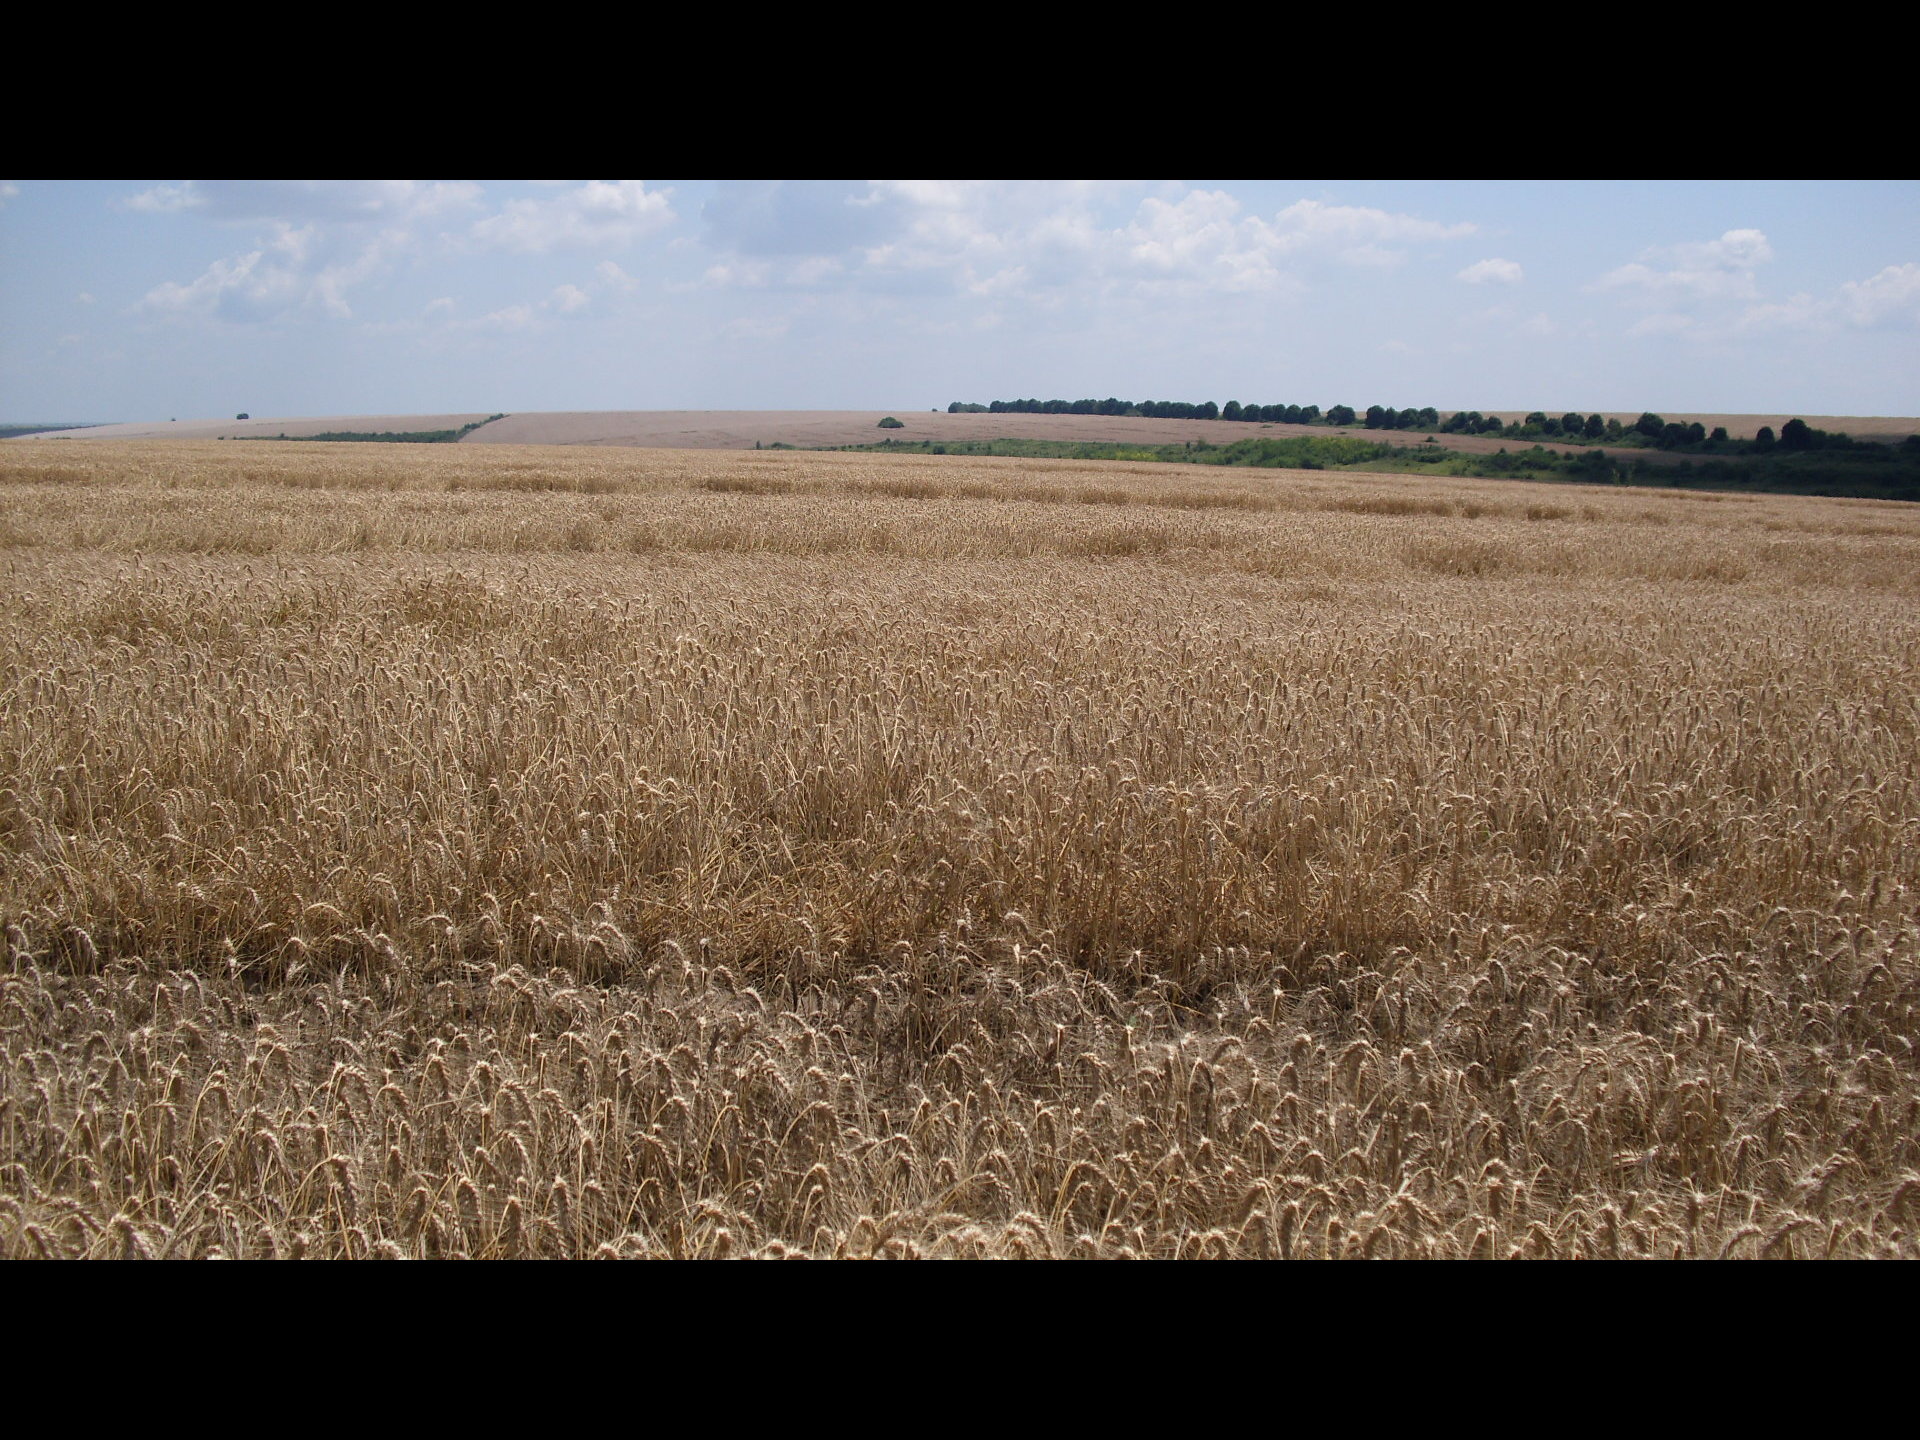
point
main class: Cropland
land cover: Common wheat
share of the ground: > 75 %
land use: Agriculture (excluding fallow land and kitchen gardens)
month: July
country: BG
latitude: 43.7820
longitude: 23.3021
